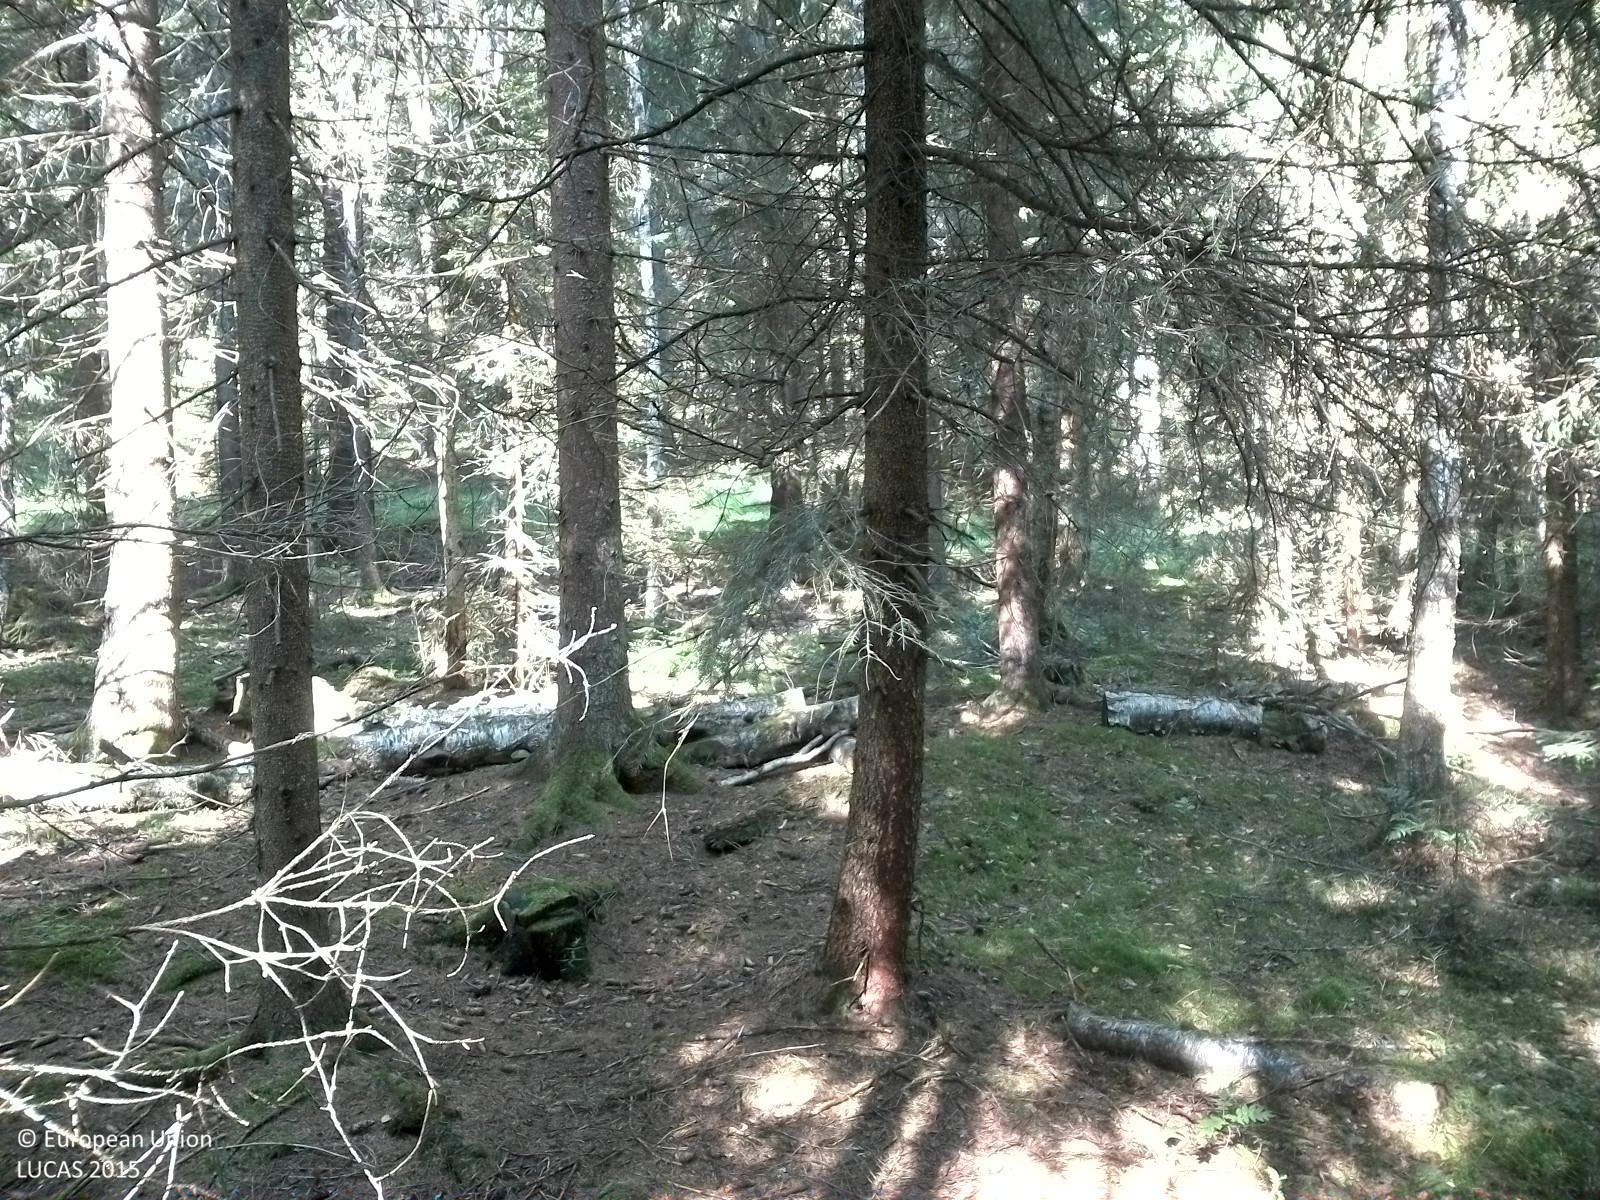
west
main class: Woodland
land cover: Spruce dominated mixed woodland
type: boreal forest
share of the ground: 50 - 75 %
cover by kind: coniferous forest trees 45 %, lichens and mosses 20 %, broadleaved forest trees 15 %, herbaceous plants 10 %, consolidated bare surface 10 %
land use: Forestry
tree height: < 5 m
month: August
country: SE
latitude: 58.7913
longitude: 15.0626
